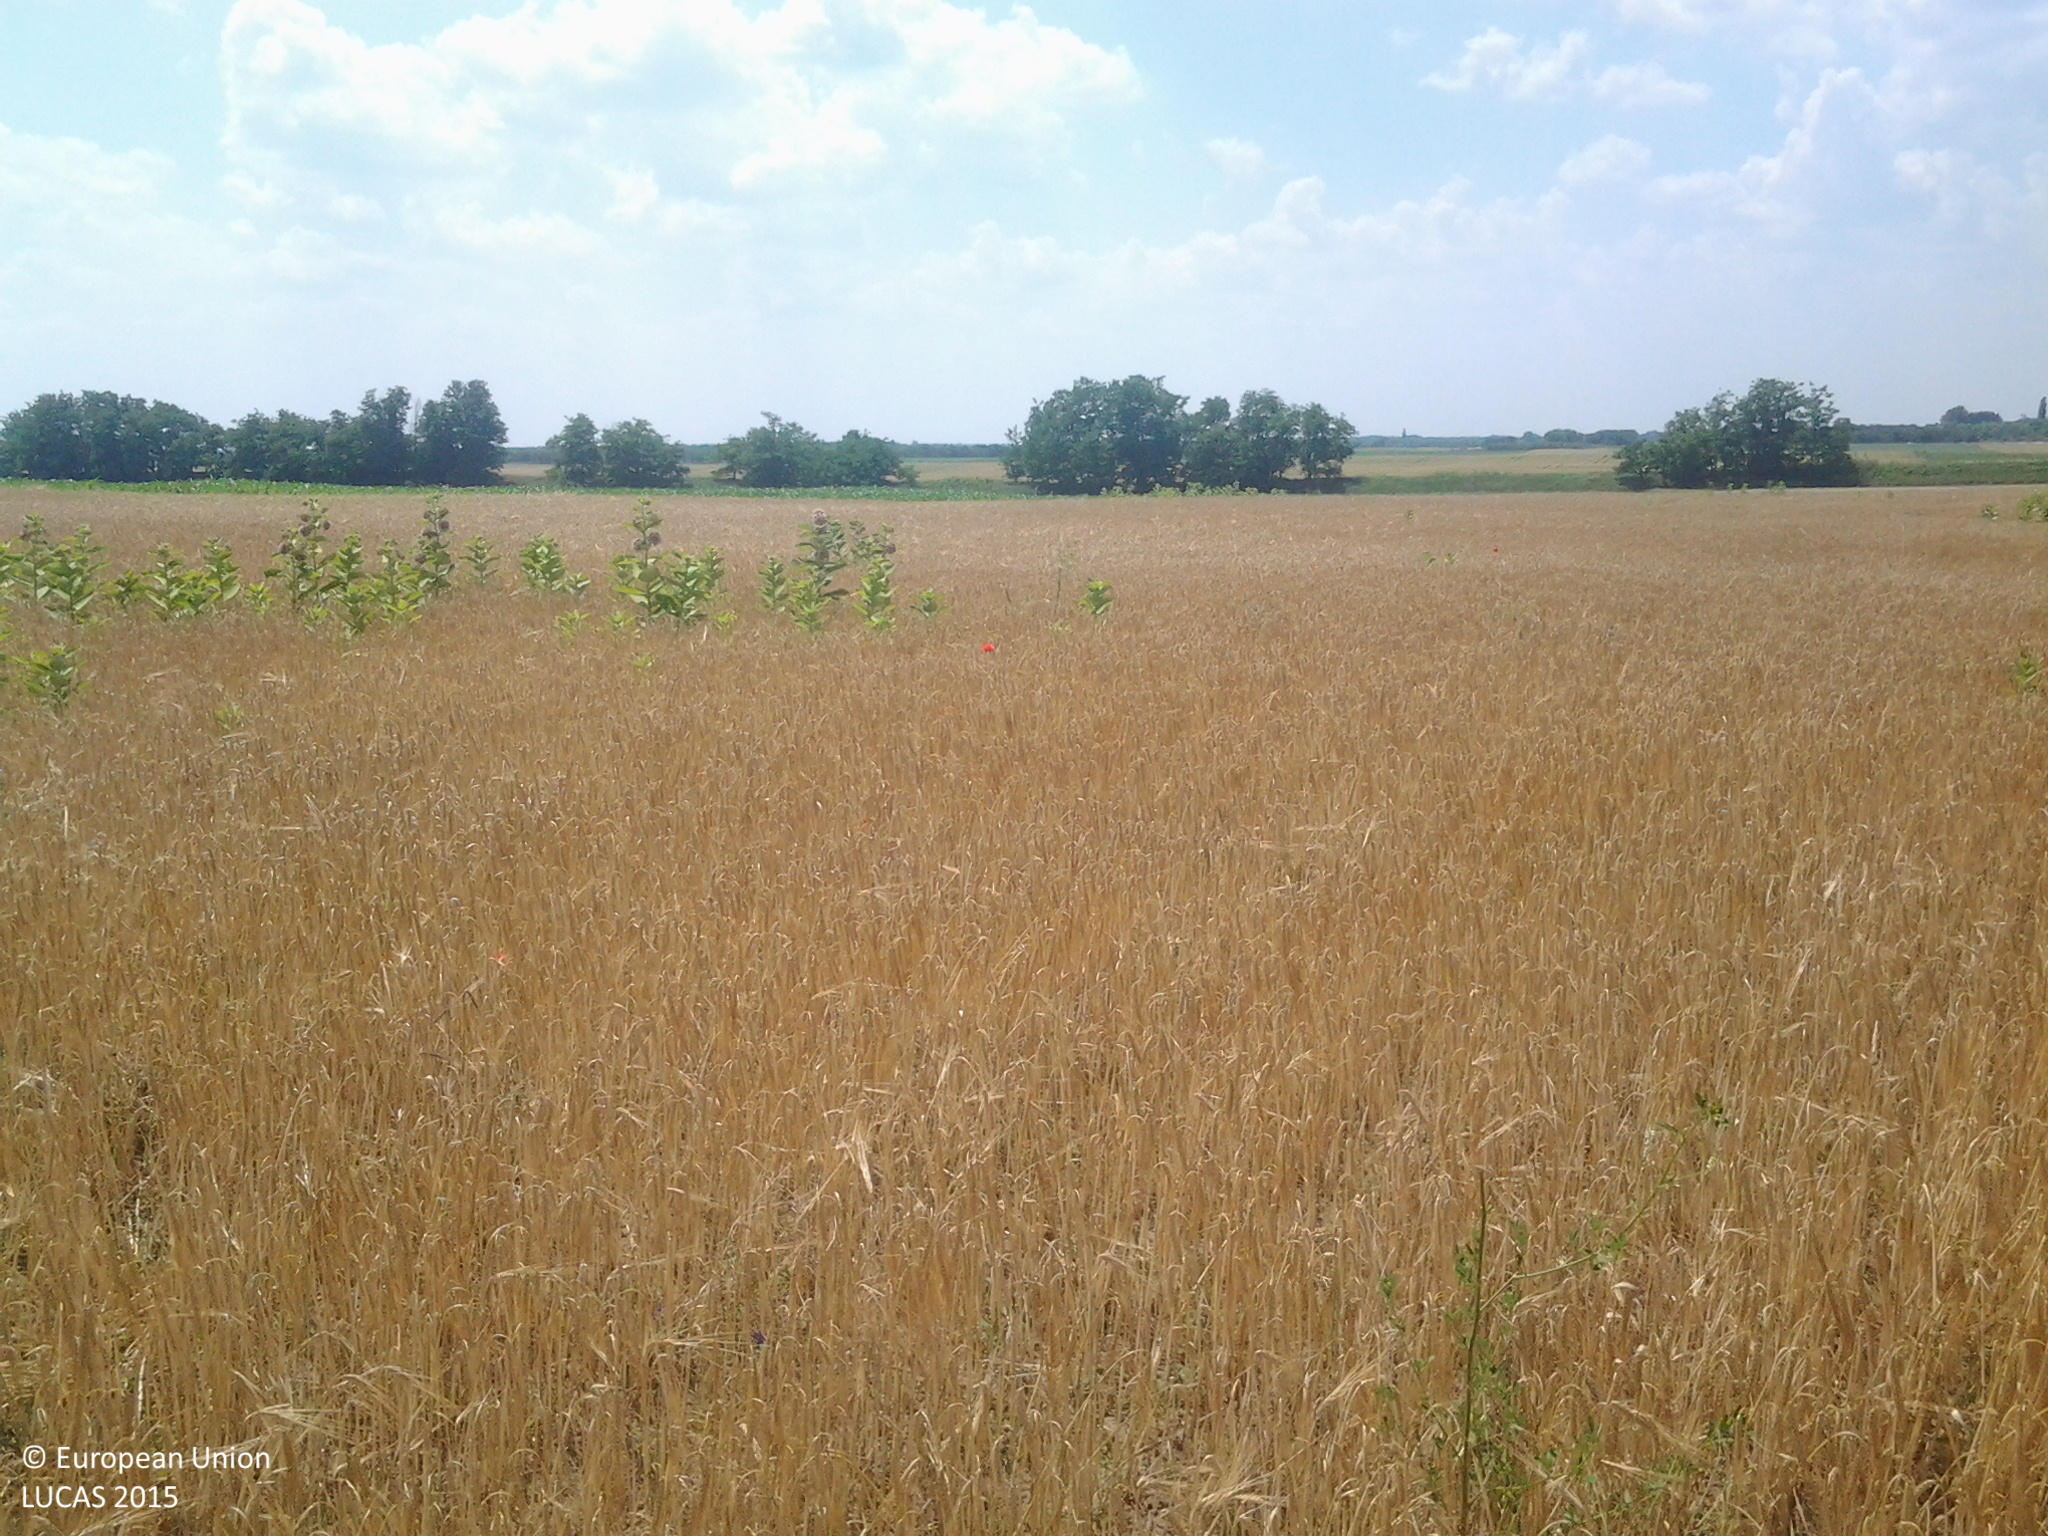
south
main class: Cropland
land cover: Barley
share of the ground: > 75 %
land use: Agriculture (excluding fallow land and kitchen gardens)
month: June
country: HU
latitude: 46.8155
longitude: 19.7059
